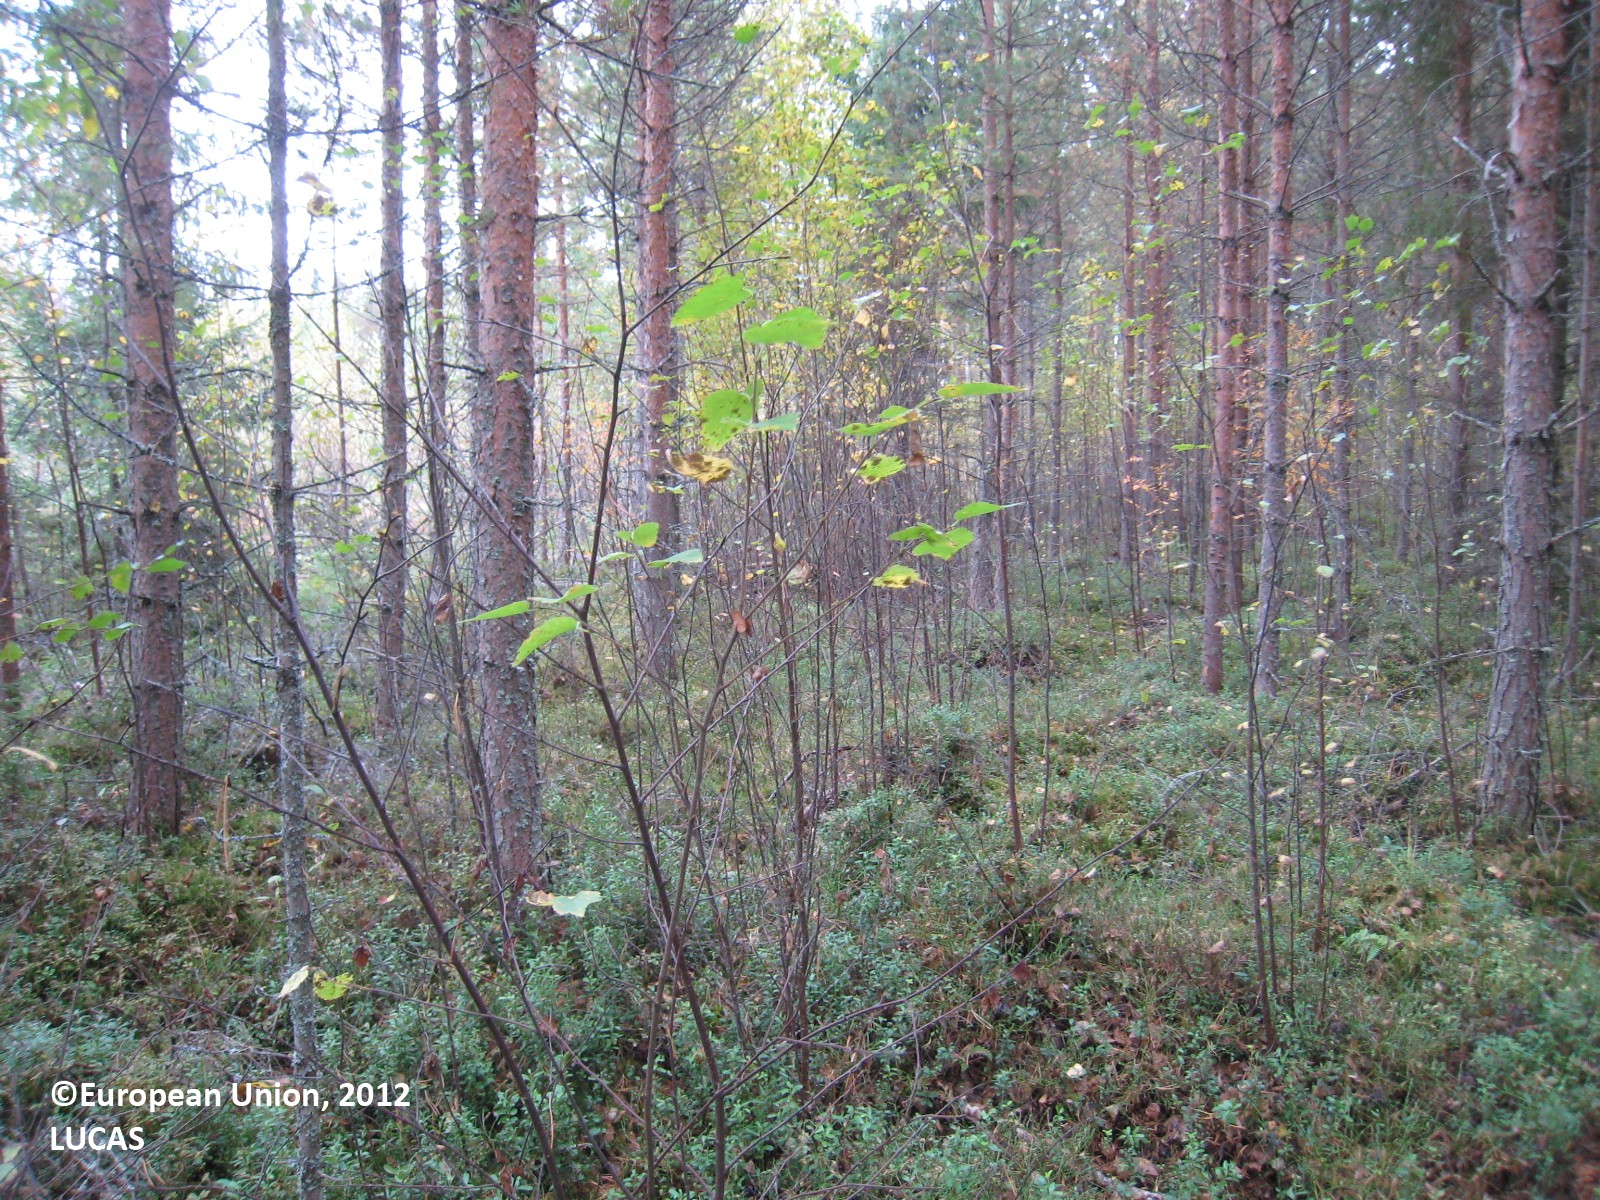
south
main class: Woodland
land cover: Pine dominated coniferous woodland
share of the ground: > 75 %
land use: Forestry
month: September
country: FI
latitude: 62.6932
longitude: 26.6501
